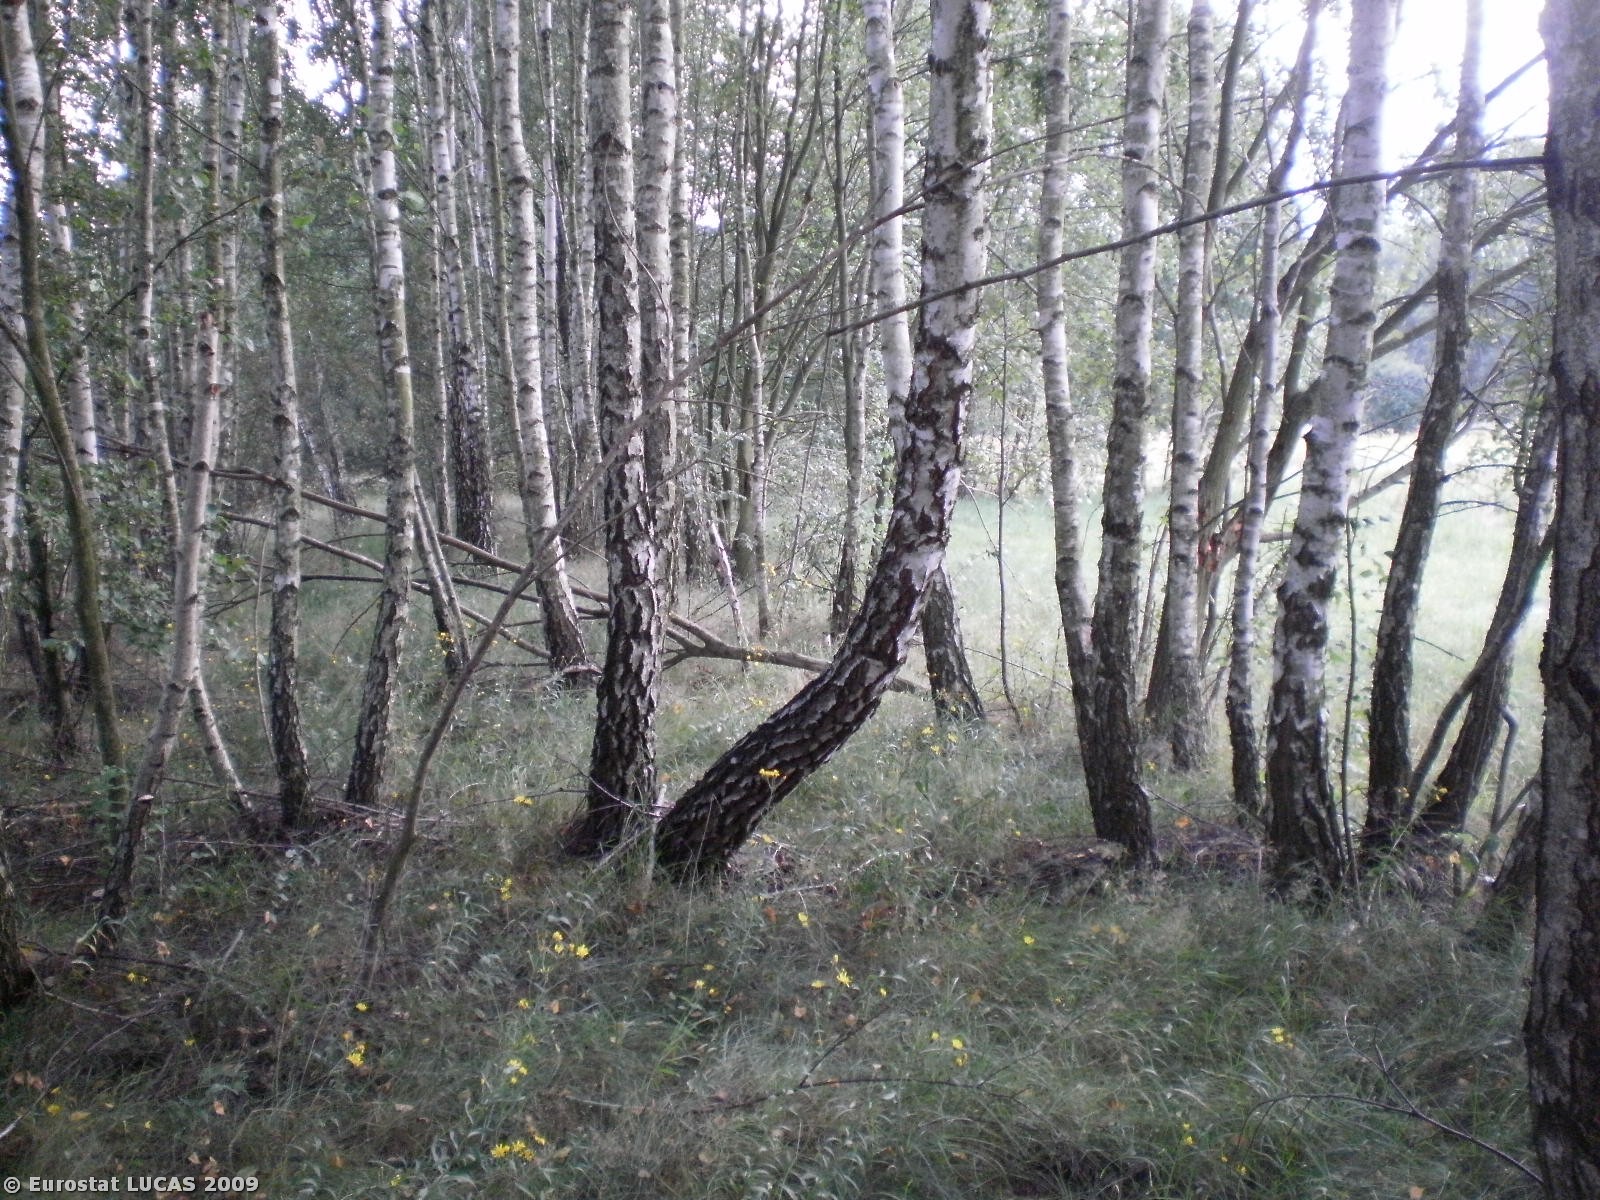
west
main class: Woodland
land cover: Broadleaved woodland
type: mesophytic deciduous forest
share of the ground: > 75 %
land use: Unused
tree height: > 5 m
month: August
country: PL
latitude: 53.0562
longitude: 21.8272
